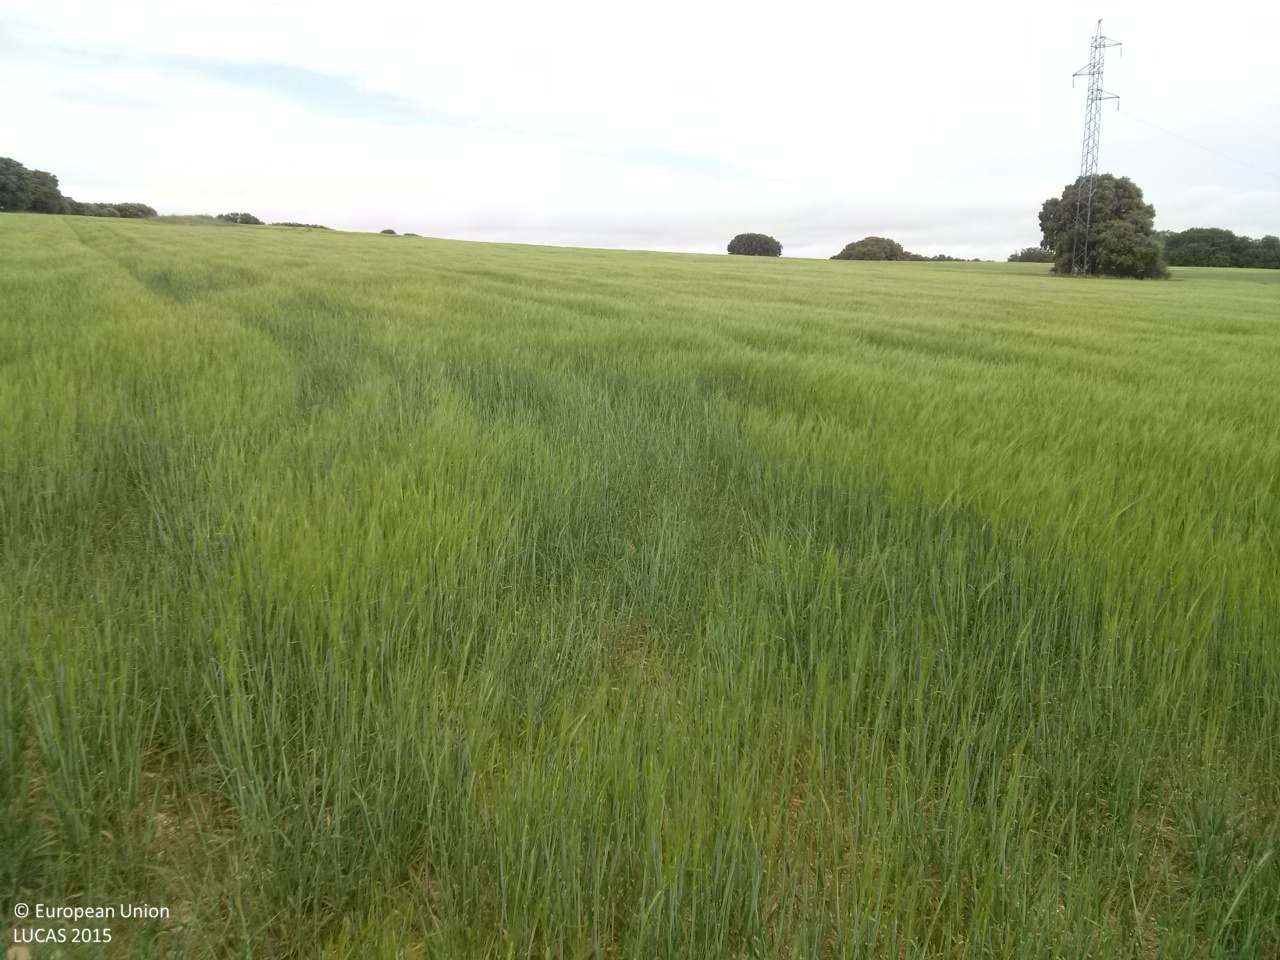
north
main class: Cropland
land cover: Barley
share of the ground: > 75 %
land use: Agriculture (excluding fallow land and kitchen gardens)
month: May
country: ES
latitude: 39.8763
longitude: -2.8467
